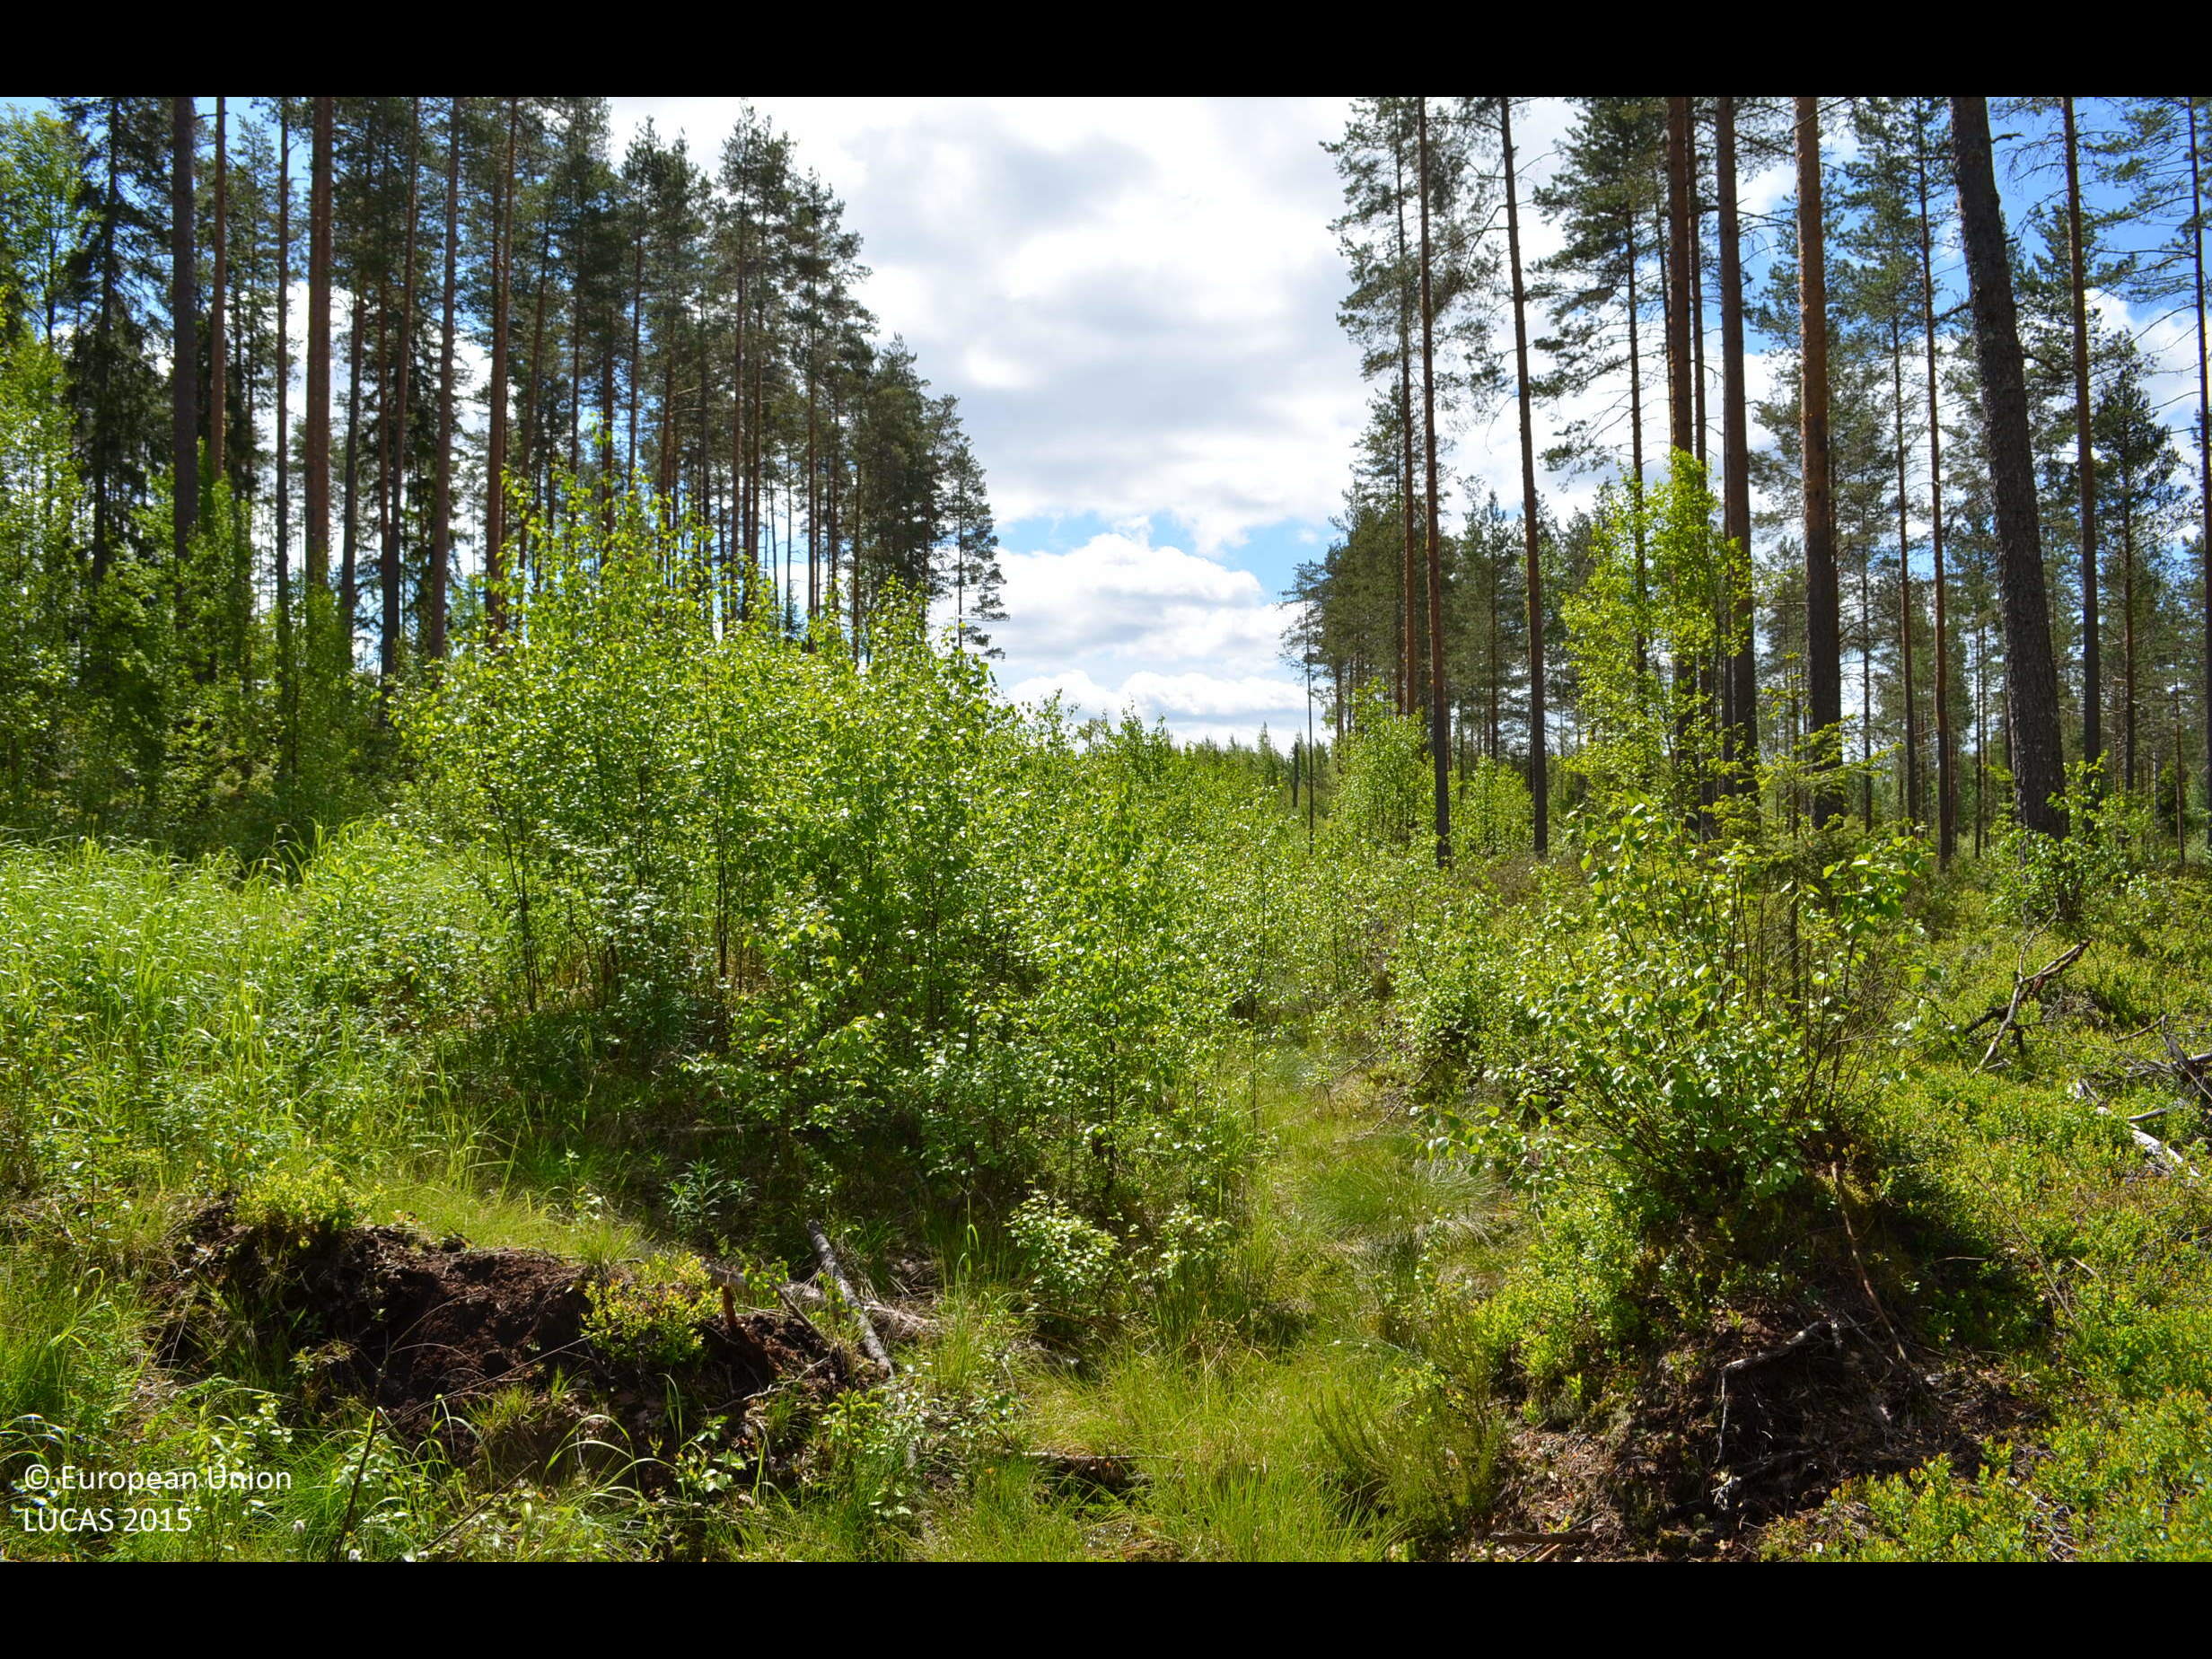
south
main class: Woodland
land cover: Pine dominated mixed woodland
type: boreal forest
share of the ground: 50 - 75 %
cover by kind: coniferous forest trees 50 %, shrubs 30 %, broadleaved forest trees 20 %
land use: Forestry
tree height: > 5 m
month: June
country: FI
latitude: 61.8339
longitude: 23.1168
